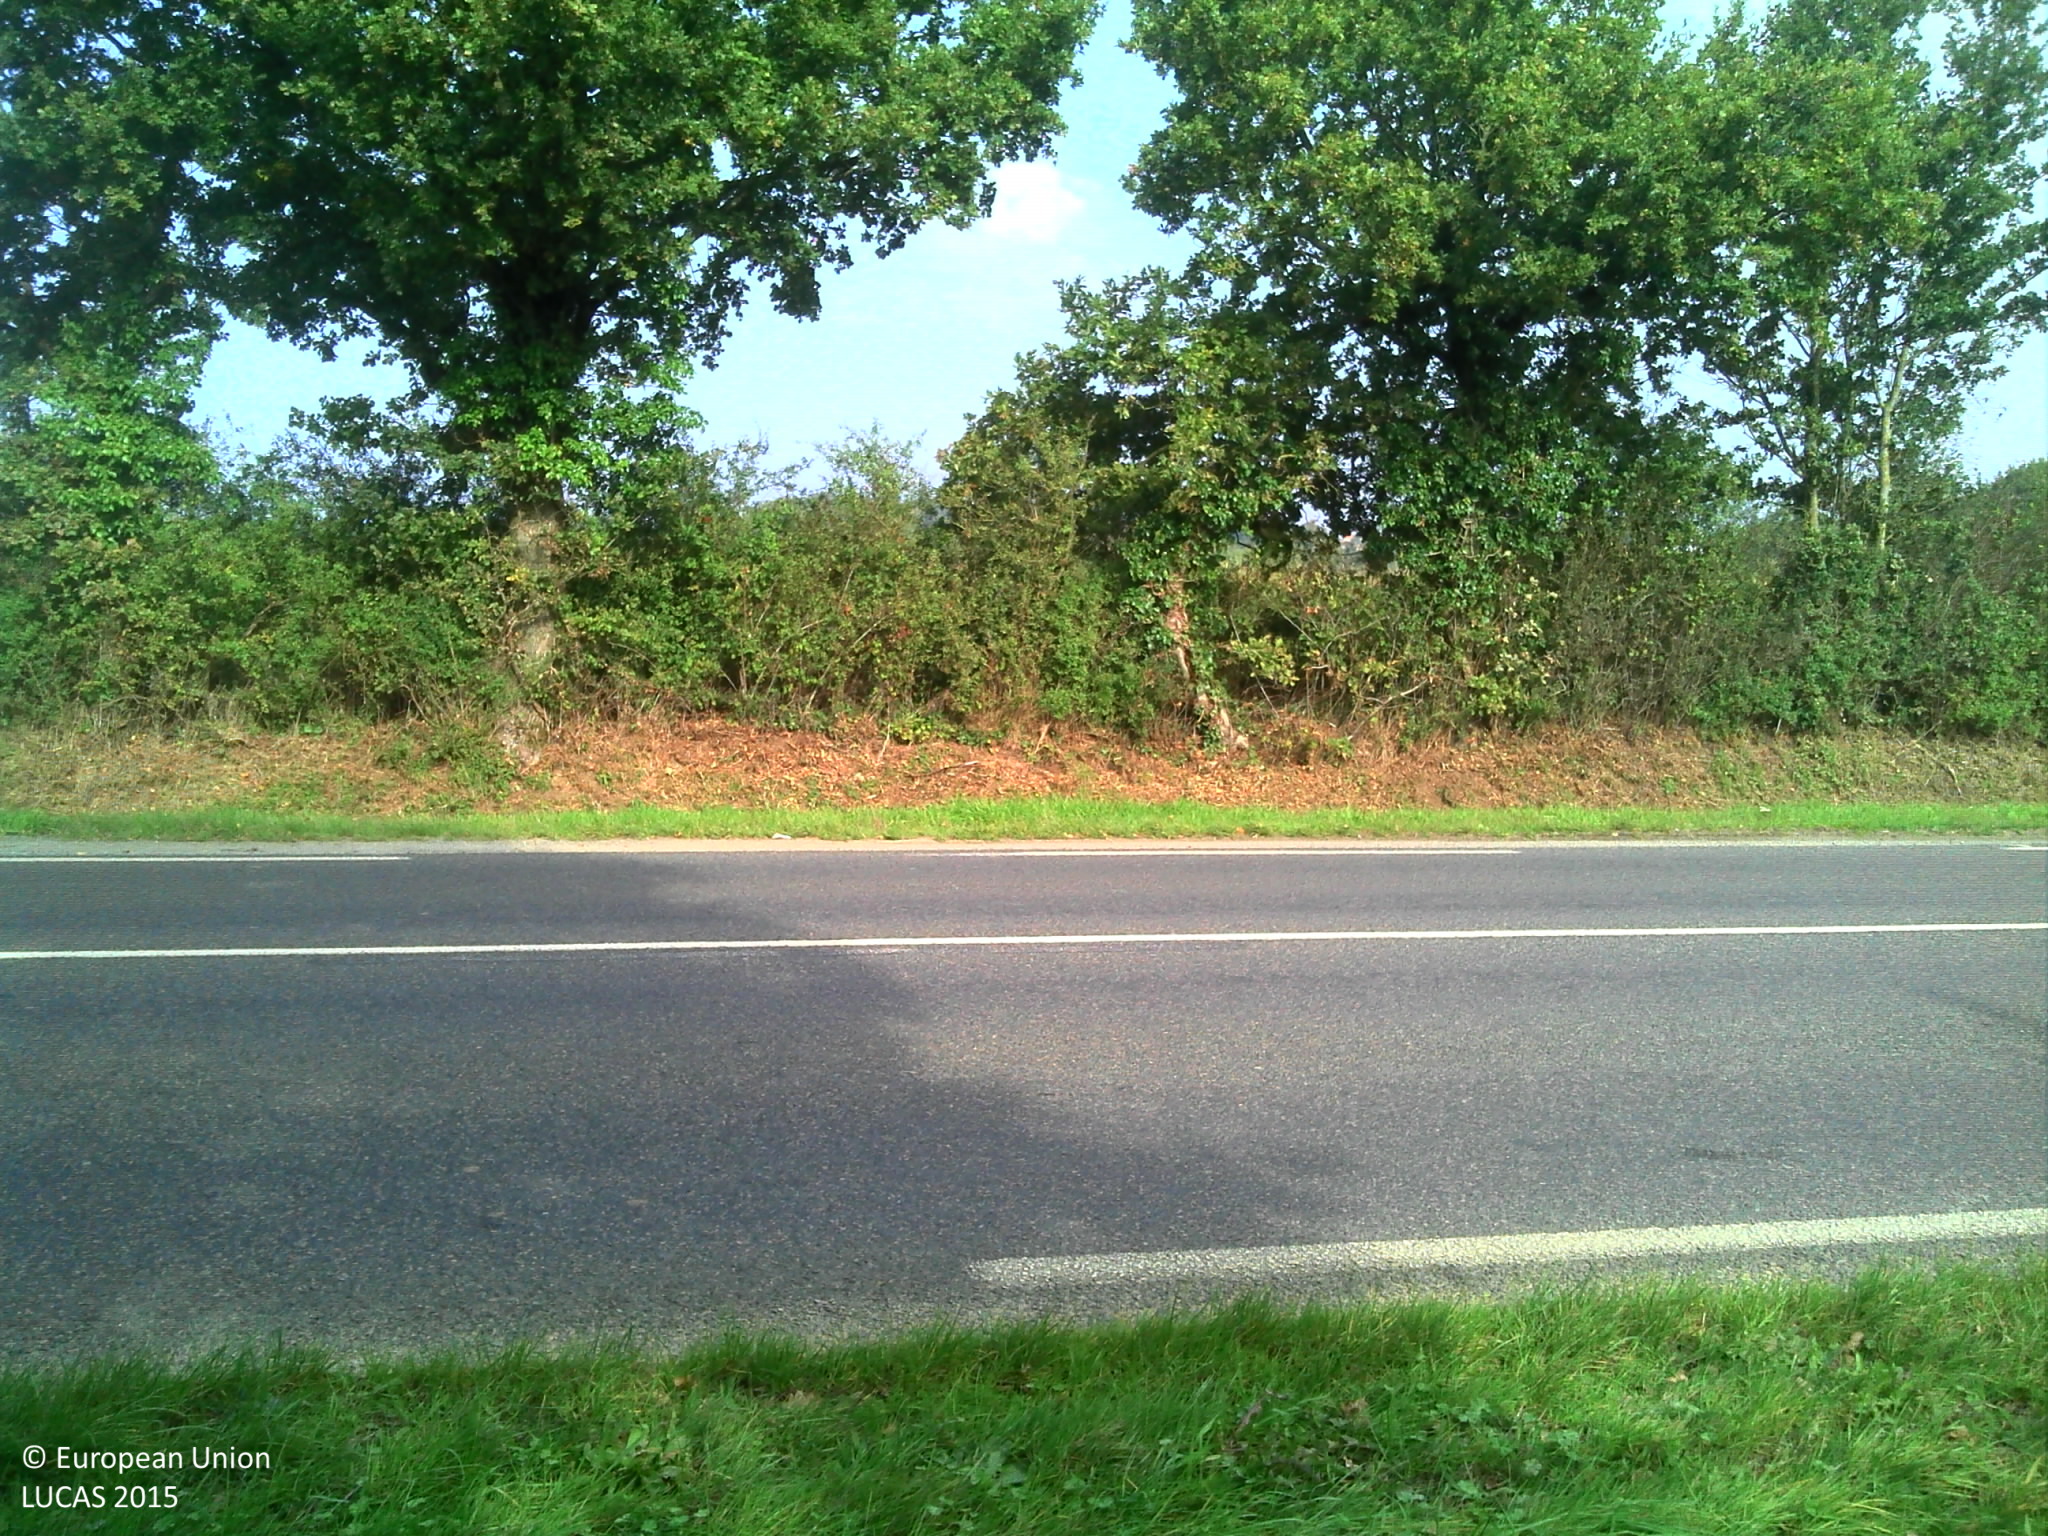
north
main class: Grassland
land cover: Grassland without tree/shrub cover
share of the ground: > 75 %
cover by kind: herbaceous plants 100 %
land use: Road transport
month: October
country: FR
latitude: 47.0591
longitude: -0.9483
